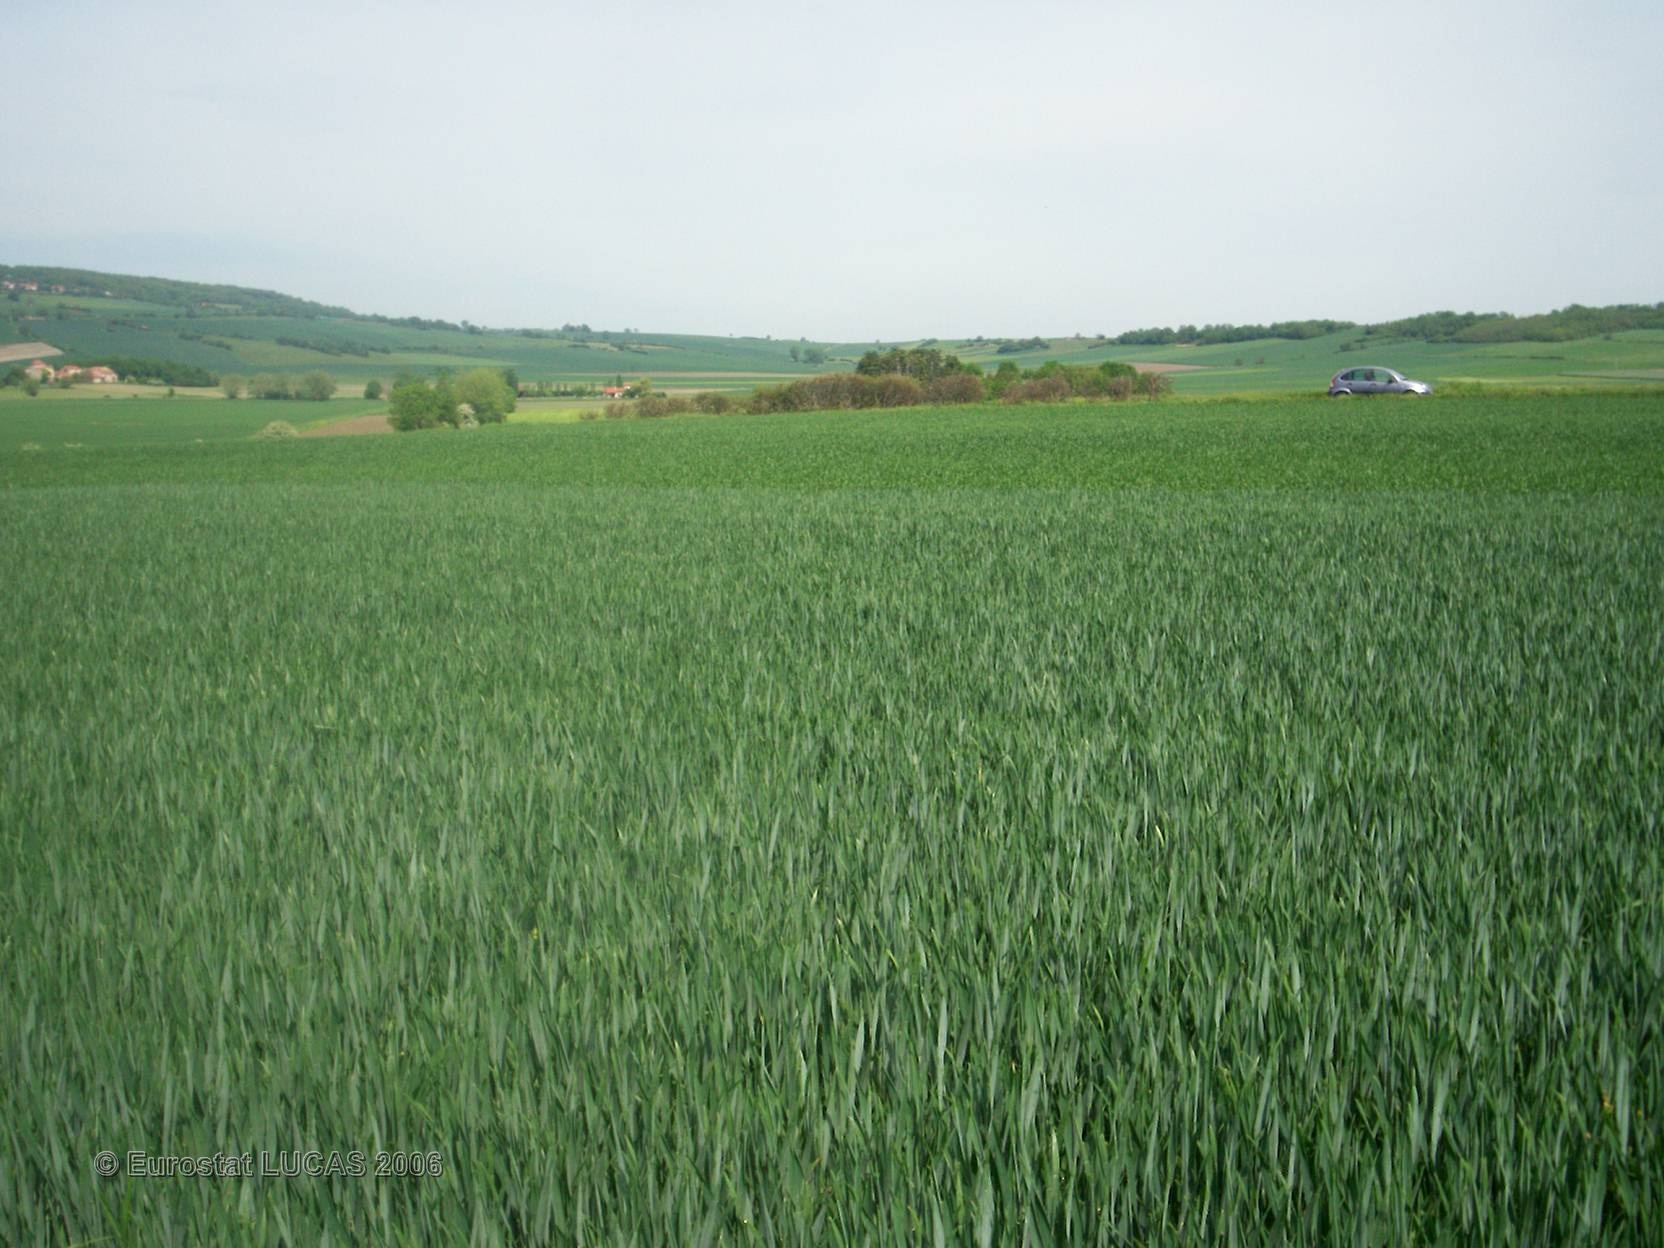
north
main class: Cropland
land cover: Common wheat
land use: Agriculture (excluding fallow land and kitchen gardens)
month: May
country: FR
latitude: 45.5024
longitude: 3.2051
